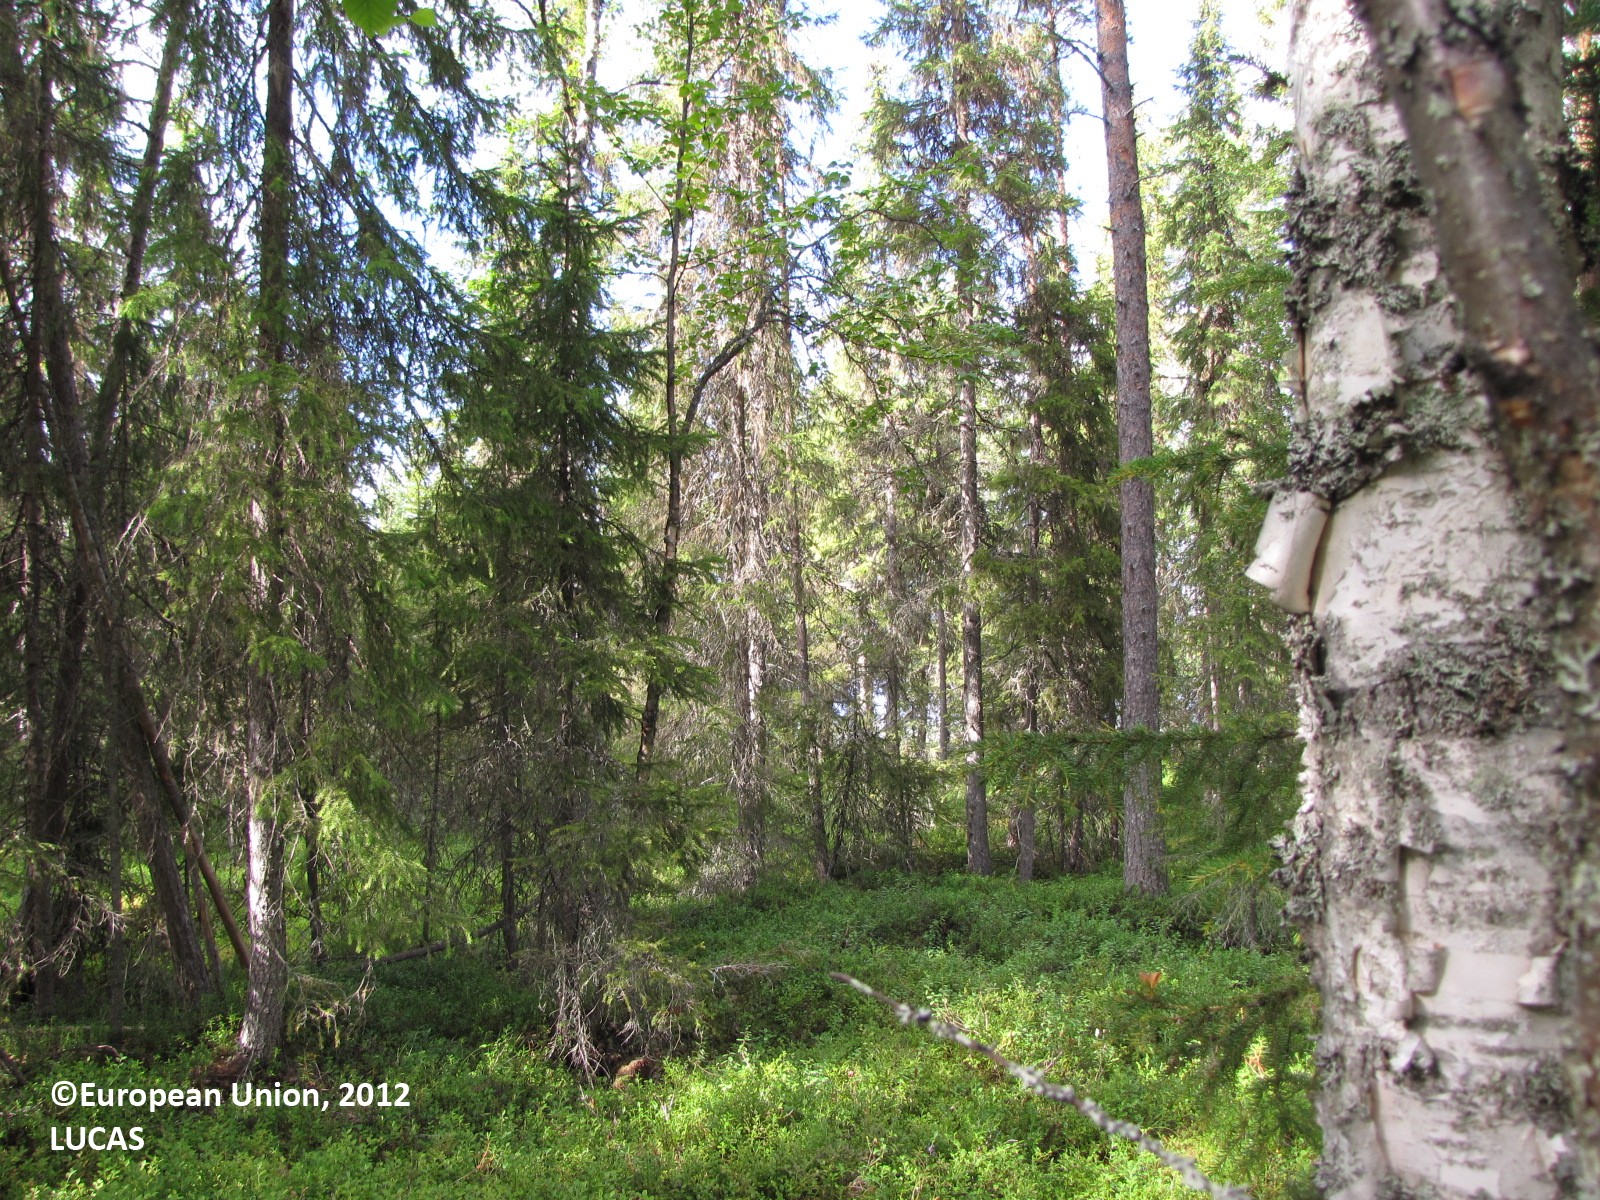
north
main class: Woodland
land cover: Other coniferous woodland
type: boreal forest
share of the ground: 25 - 50 %
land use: Forestry
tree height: > 5 m
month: August
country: FI
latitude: 66.8626
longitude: 25.1724
